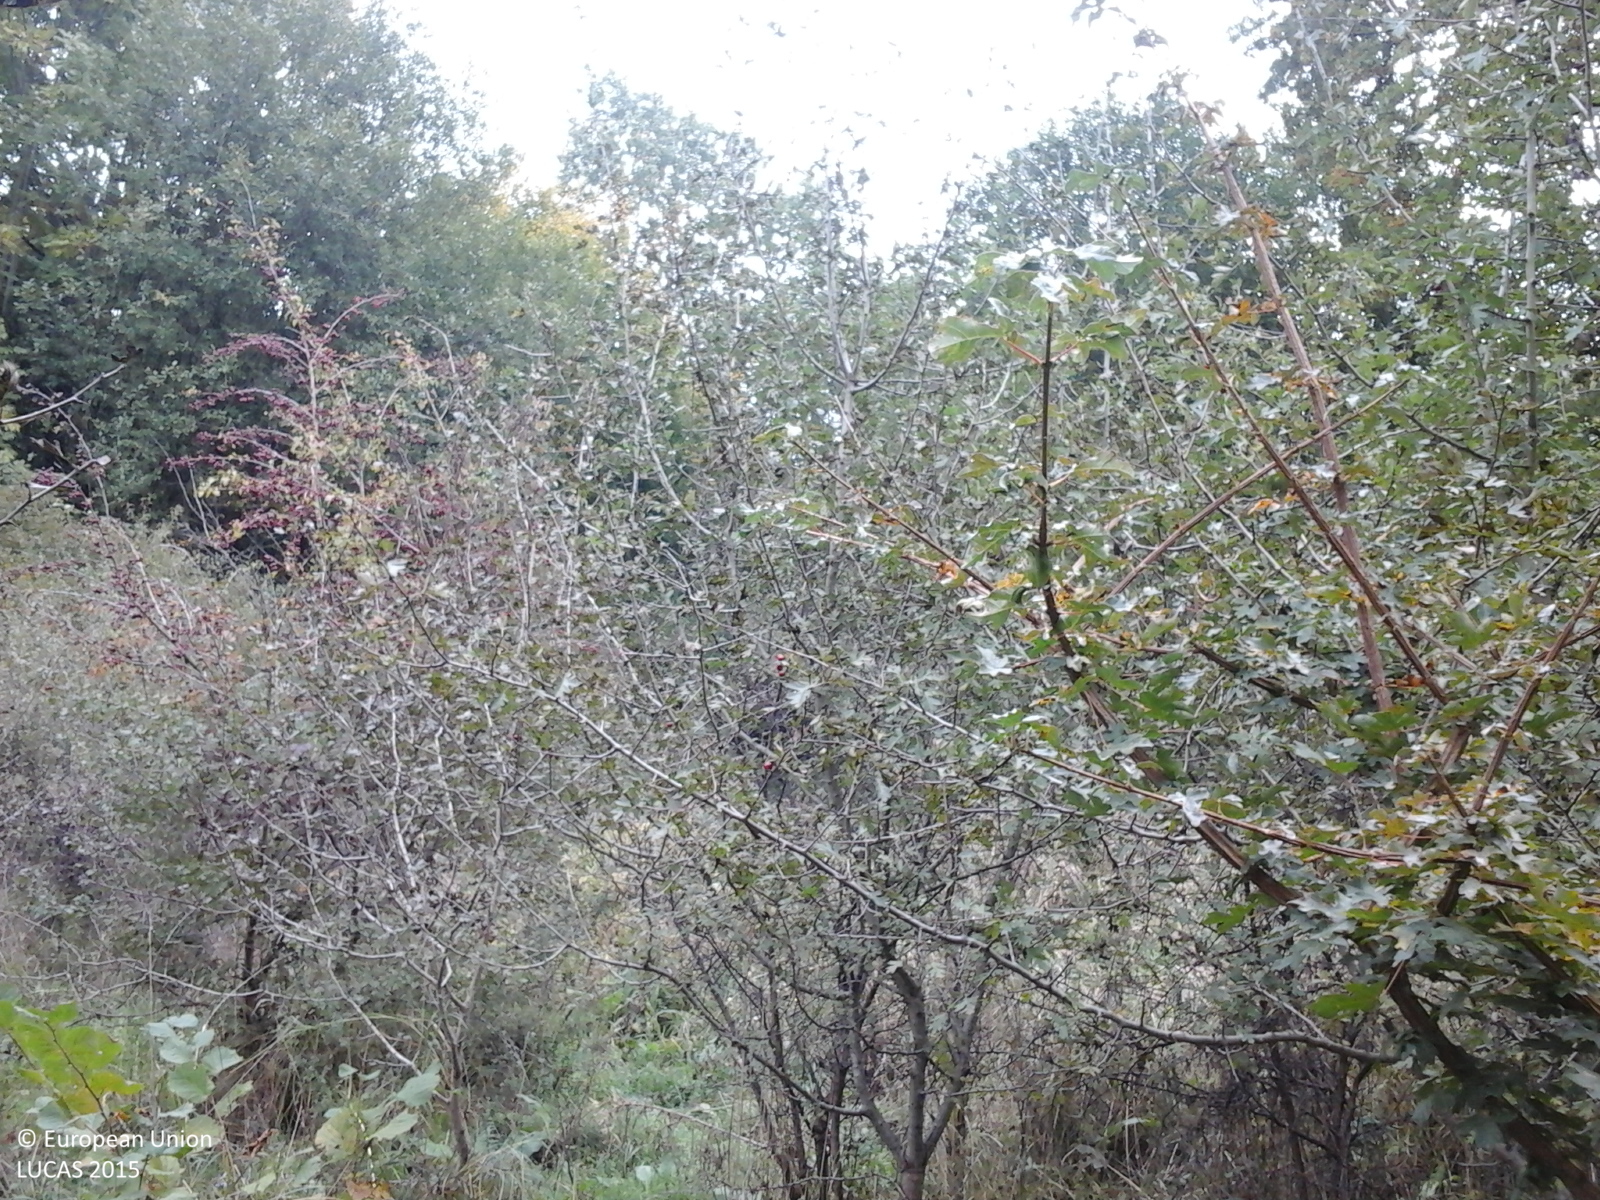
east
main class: Shrubland
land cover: Shrubland with sparse tree cover
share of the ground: > 75 %
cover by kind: shrubs 85 %, herbaceous plants 10 %, broadleaved forest trees 5 %
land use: Fallow land
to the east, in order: Shrubland with sparse tree cover; Single bushes/trees; Grassland with sparse tree/shrub cover; Tracks; Grassland with sparse tree/shrub cover; Broadleaved woodland; Grassland with sparse tree/shrub cover; Broadleaved woodland
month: October
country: RO
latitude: 46.2917
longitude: 24.8784
